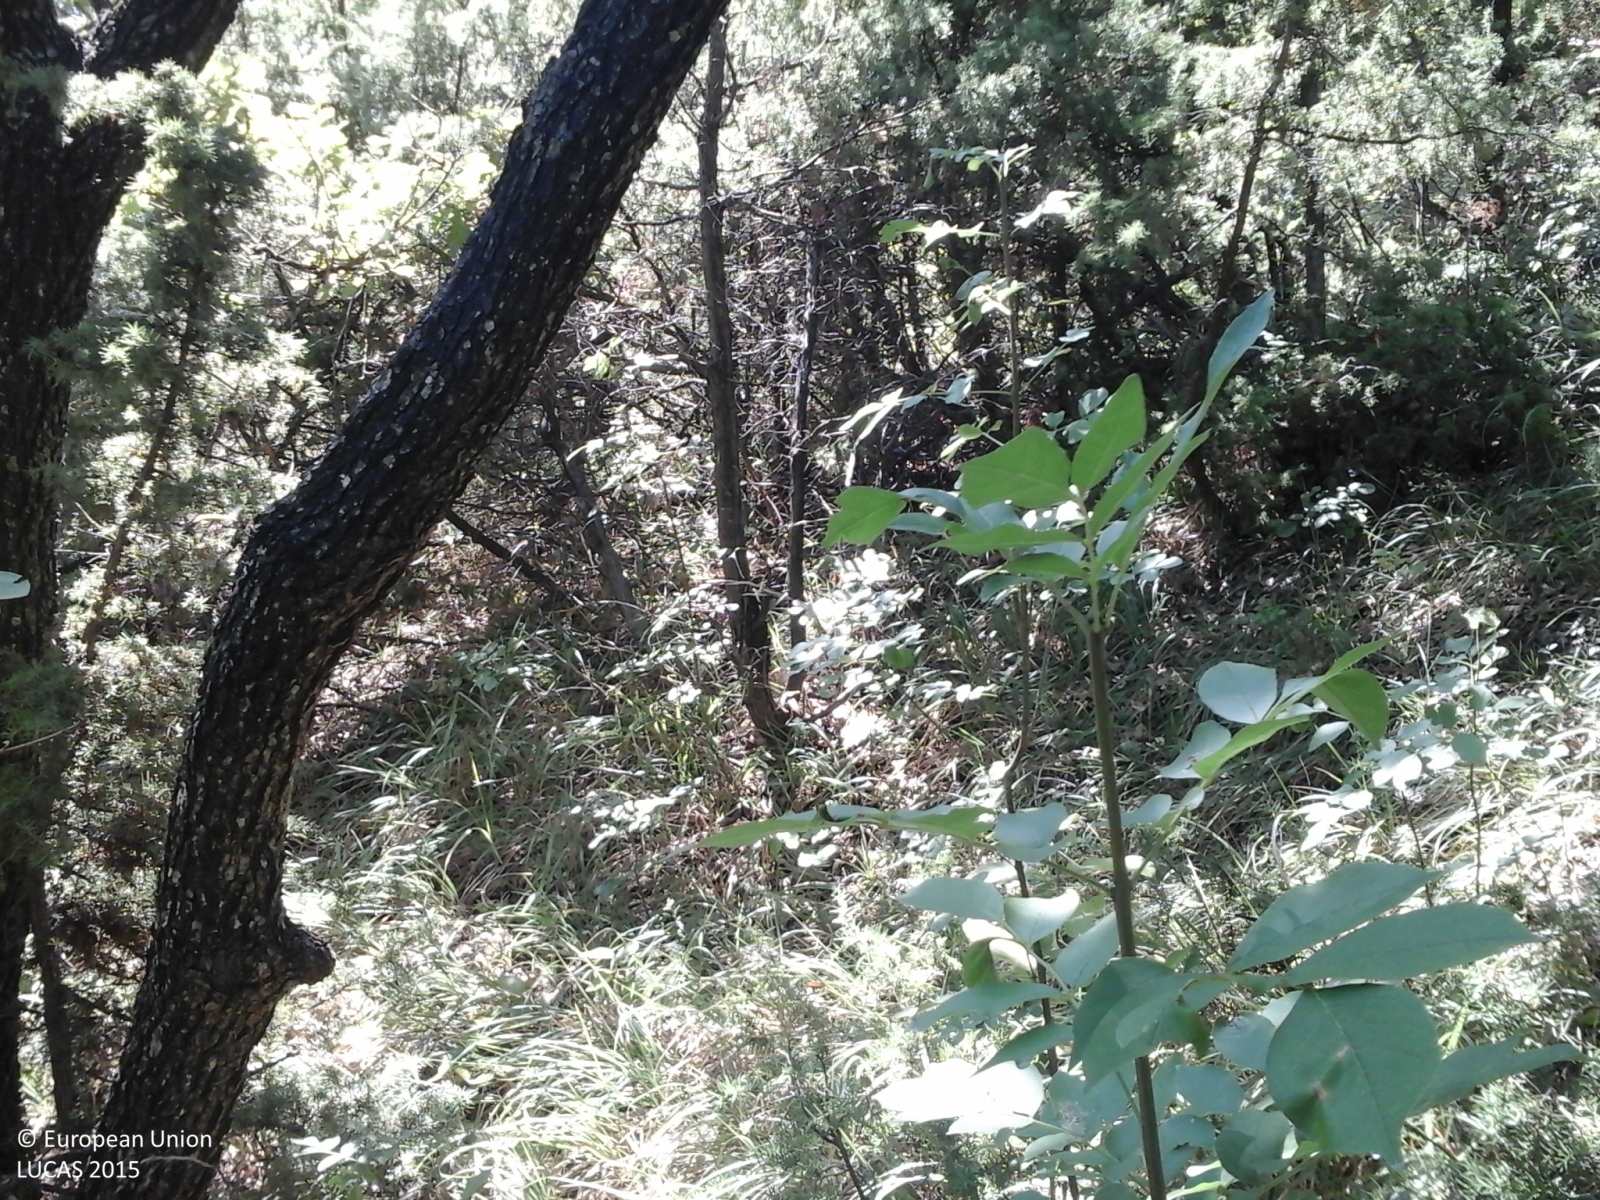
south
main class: Woodland
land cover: Broadleaved woodland
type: thermophilous deciduous forest
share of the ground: > 75 %
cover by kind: broadleaved forest trees 100 %
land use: Forestry
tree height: > 5 m
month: August
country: IT
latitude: 44.8156
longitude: 9.1040
